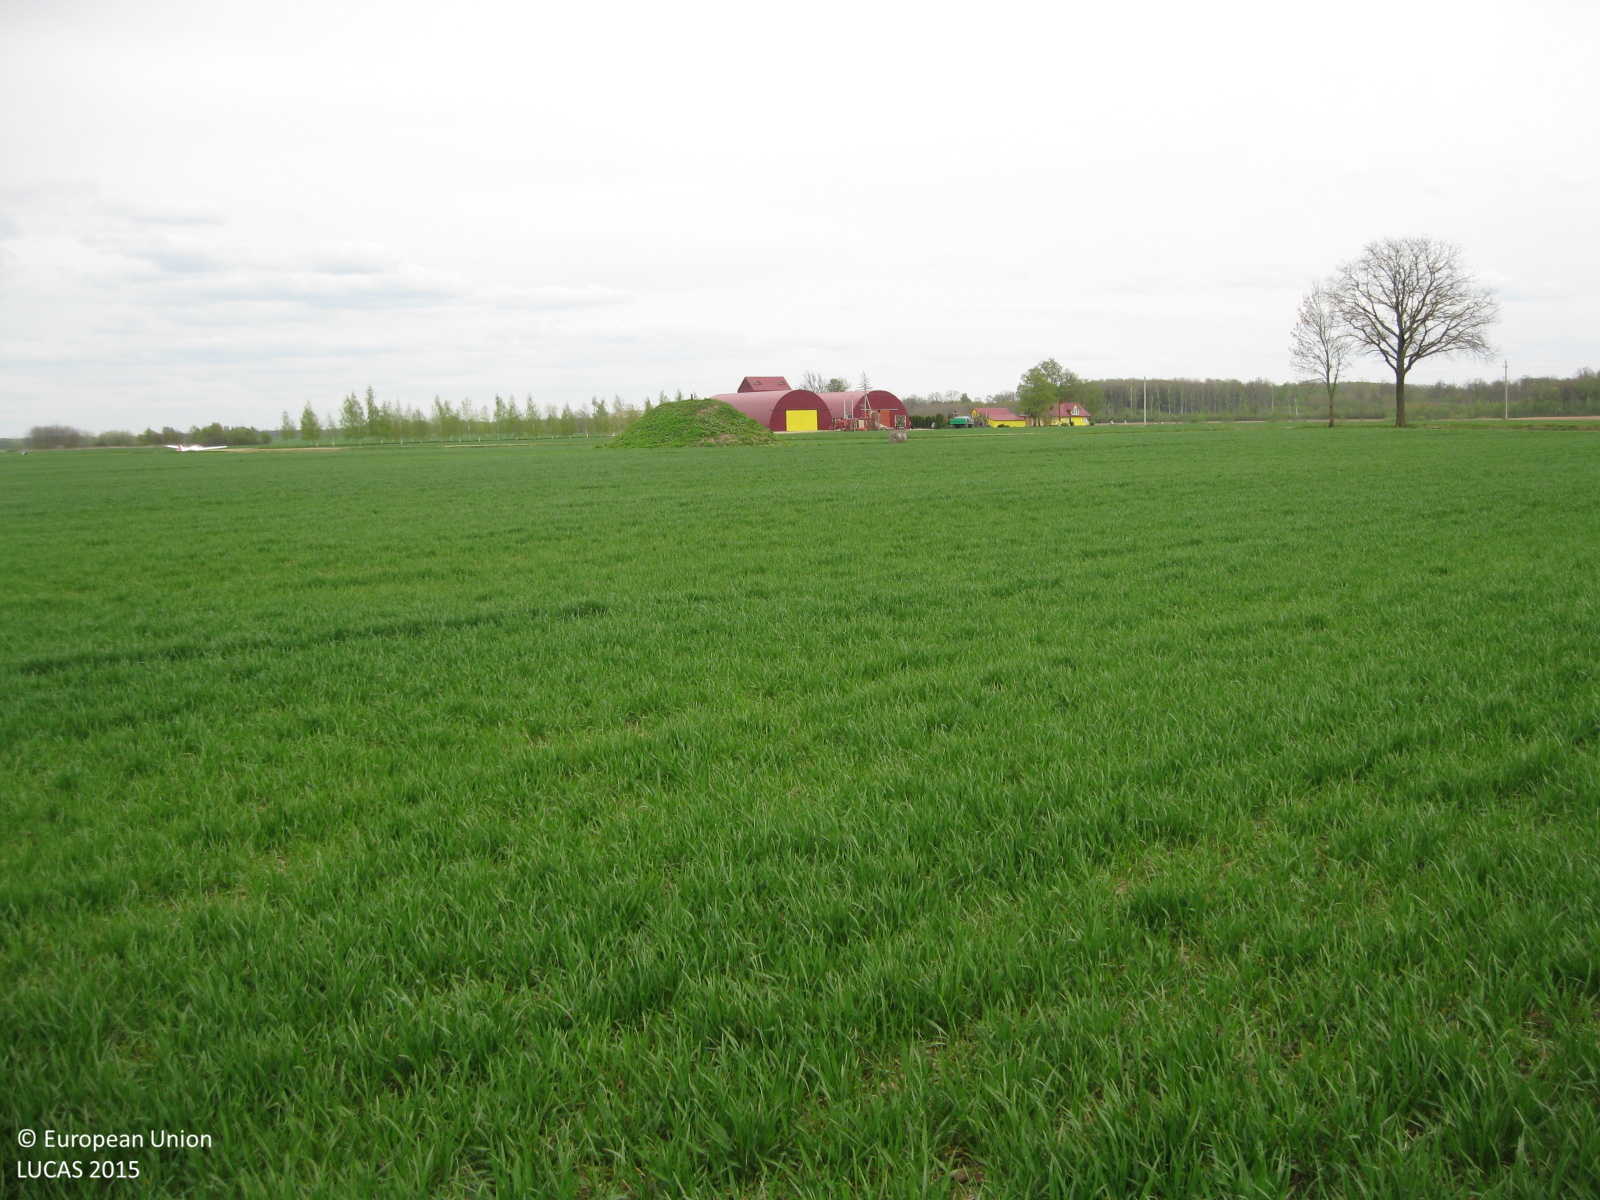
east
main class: Cropland
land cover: Common wheat
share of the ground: > 75 %
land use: Agriculture (excluding fallow land and kitchen gardens)
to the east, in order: Common wheat
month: May
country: LT
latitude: 56.1870
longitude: 24.4527
